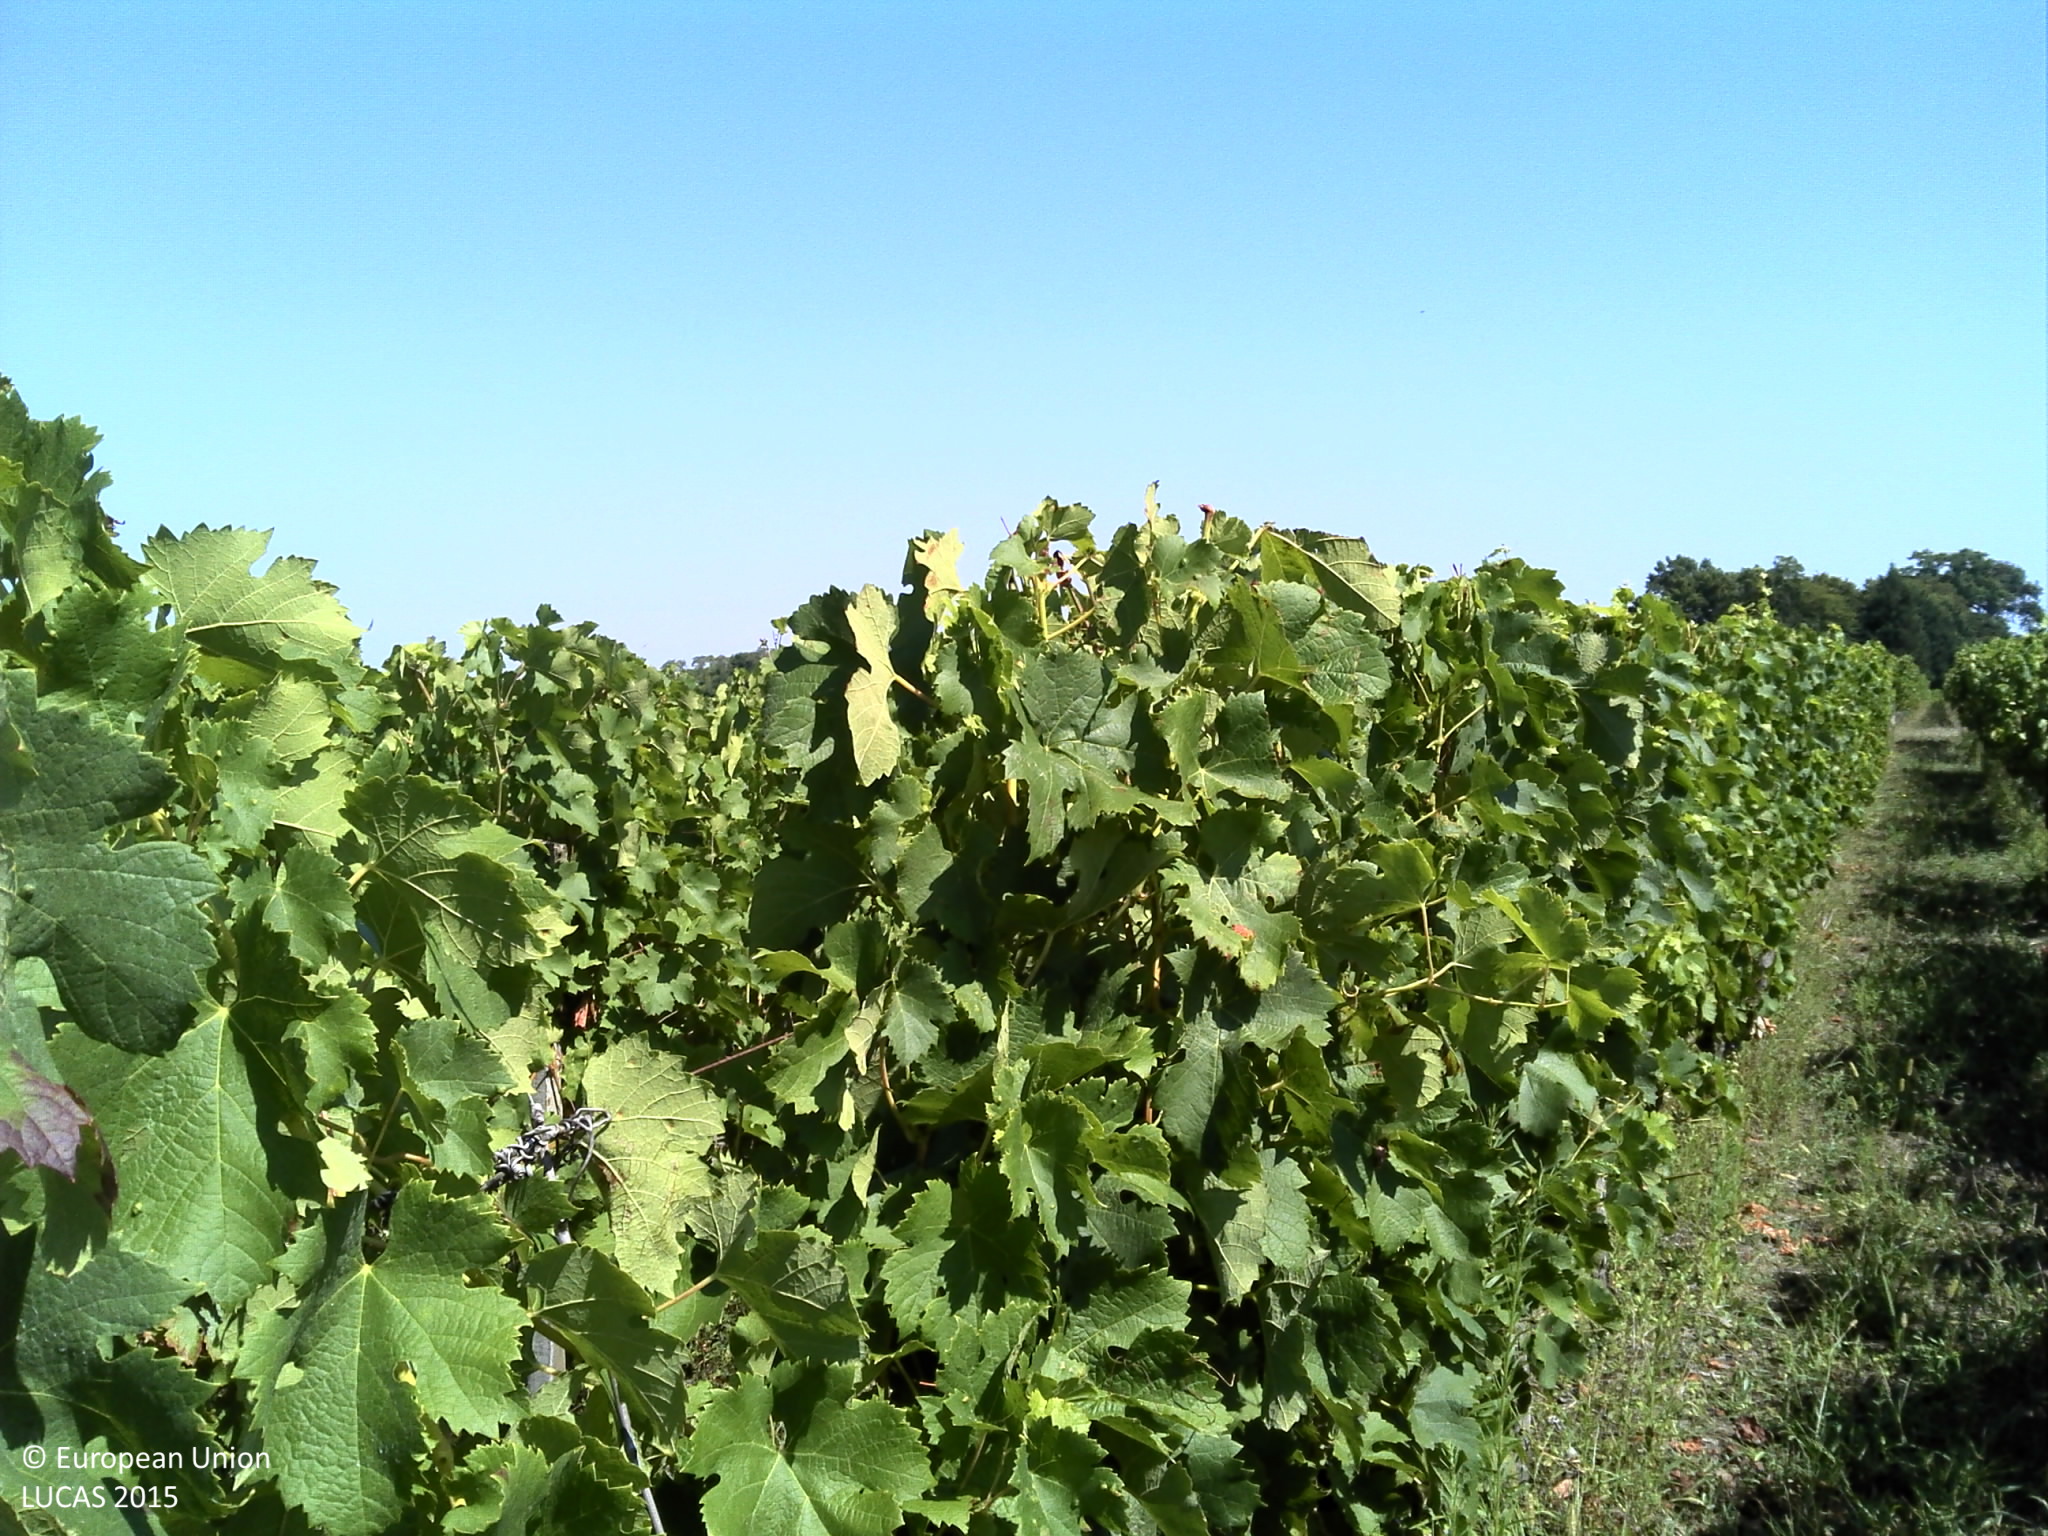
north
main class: Cropland
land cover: Vineyards
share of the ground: 25 - 50 %
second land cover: Grassland without tree/shrub cover
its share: > 75 %
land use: Agriculture (excluding fallow land and kitchen gardens)
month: August
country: FR
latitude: 45.0195
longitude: -0.4625
